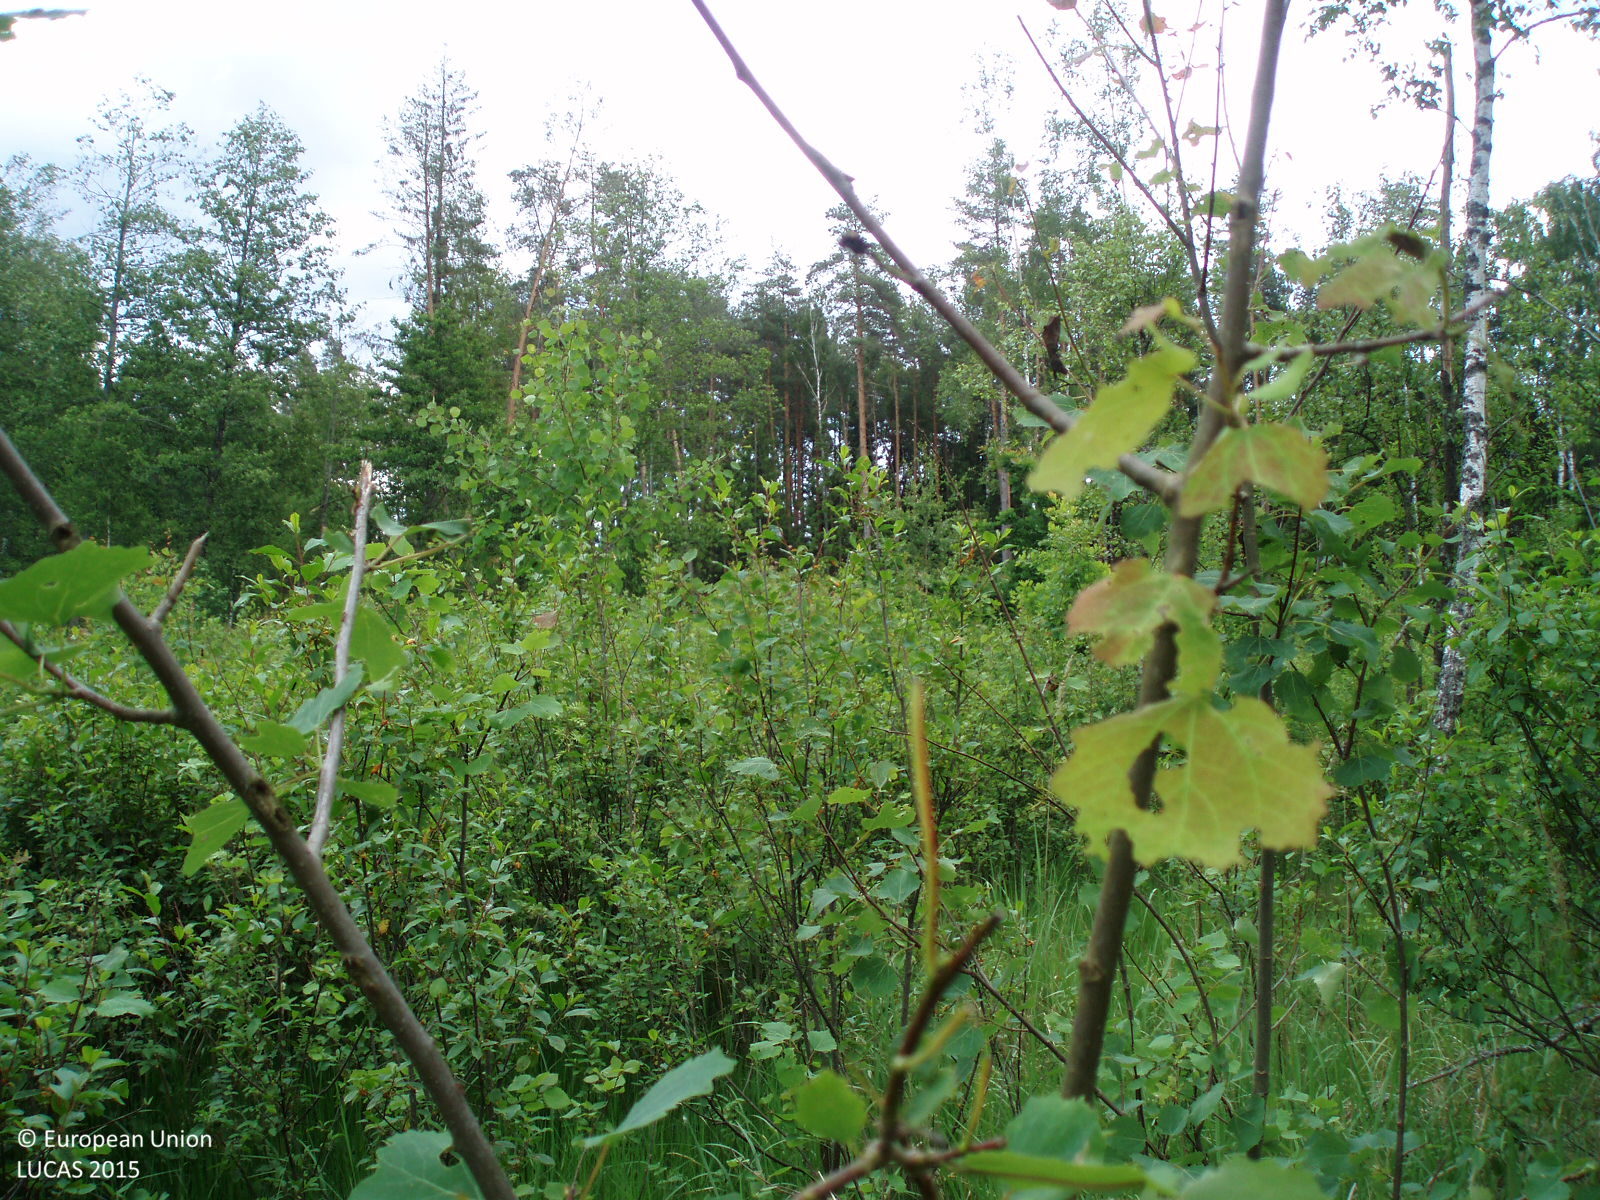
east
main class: Woodland
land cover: Broadleaved woodland
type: non-riverine alder, birch or aspen forest
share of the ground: 25 - 50 %
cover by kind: shrubs 50 %, broadleaved forest trees 30 %, herbaceous plants 20 %
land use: Forestry
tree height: < 5 m
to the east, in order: Broadleaved woodland; Pine dominated mixed woodland; Pine dominated coniferous woodland
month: June
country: LT
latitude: 55.0801
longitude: 22.5157
